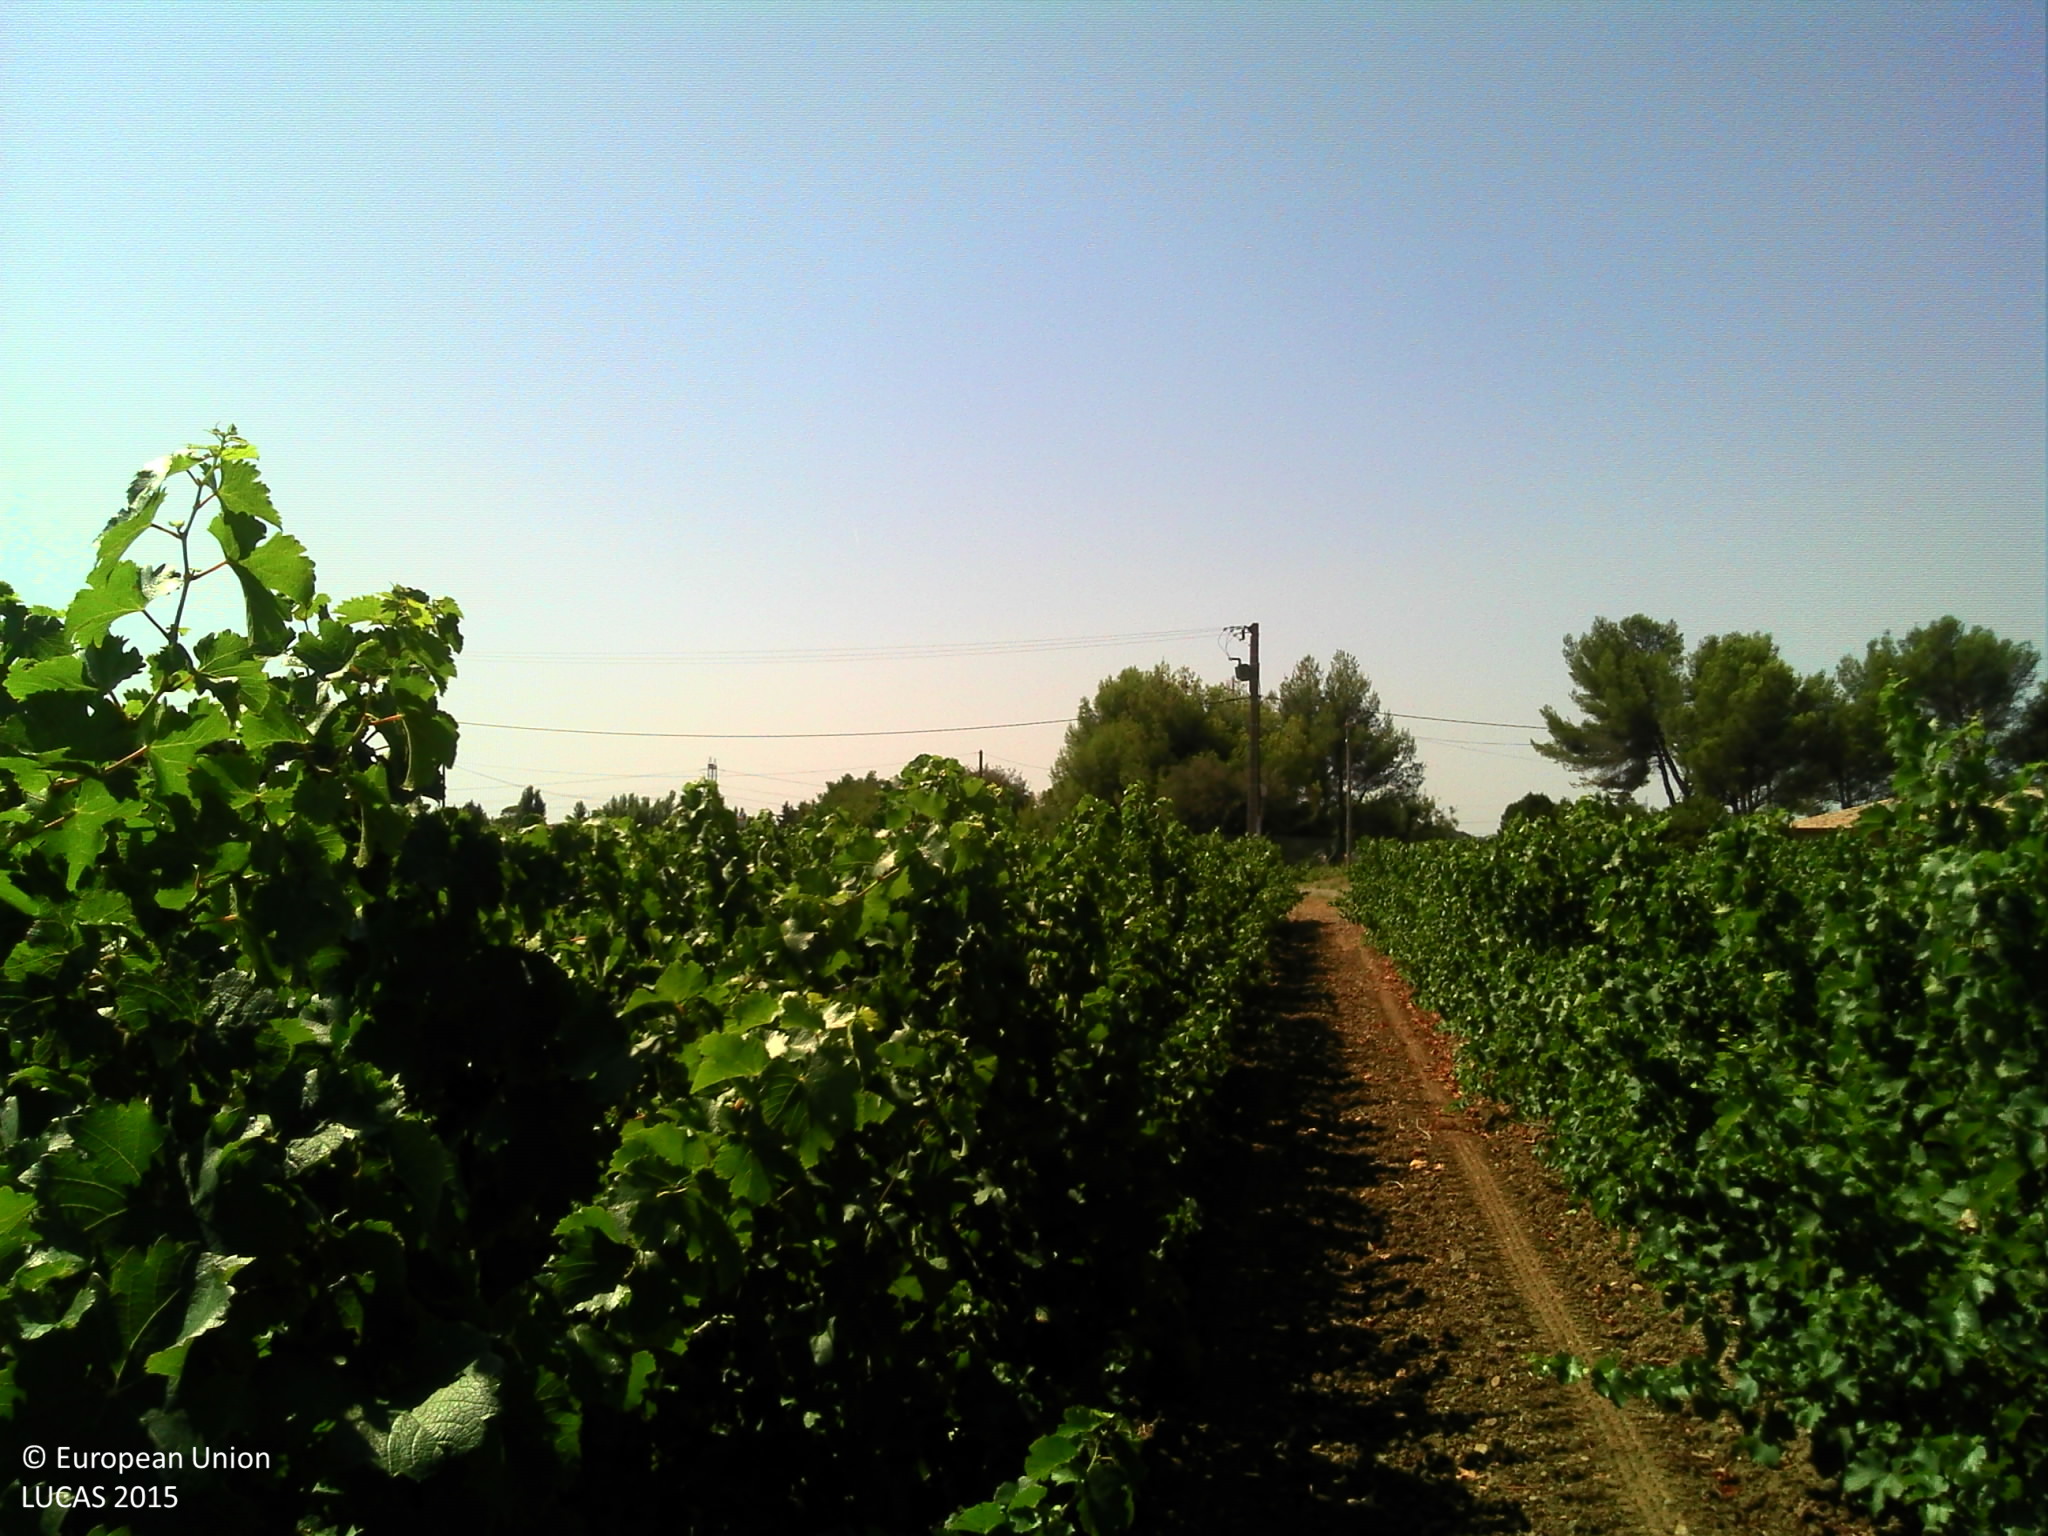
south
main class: Cropland
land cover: Vineyards
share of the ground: 10 - 25 %
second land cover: Other bare soil
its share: > 75 %
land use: Agriculture (excluding fallow land and kitchen gardens)
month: August
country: FR
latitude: 43.5620
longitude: 3.4102
